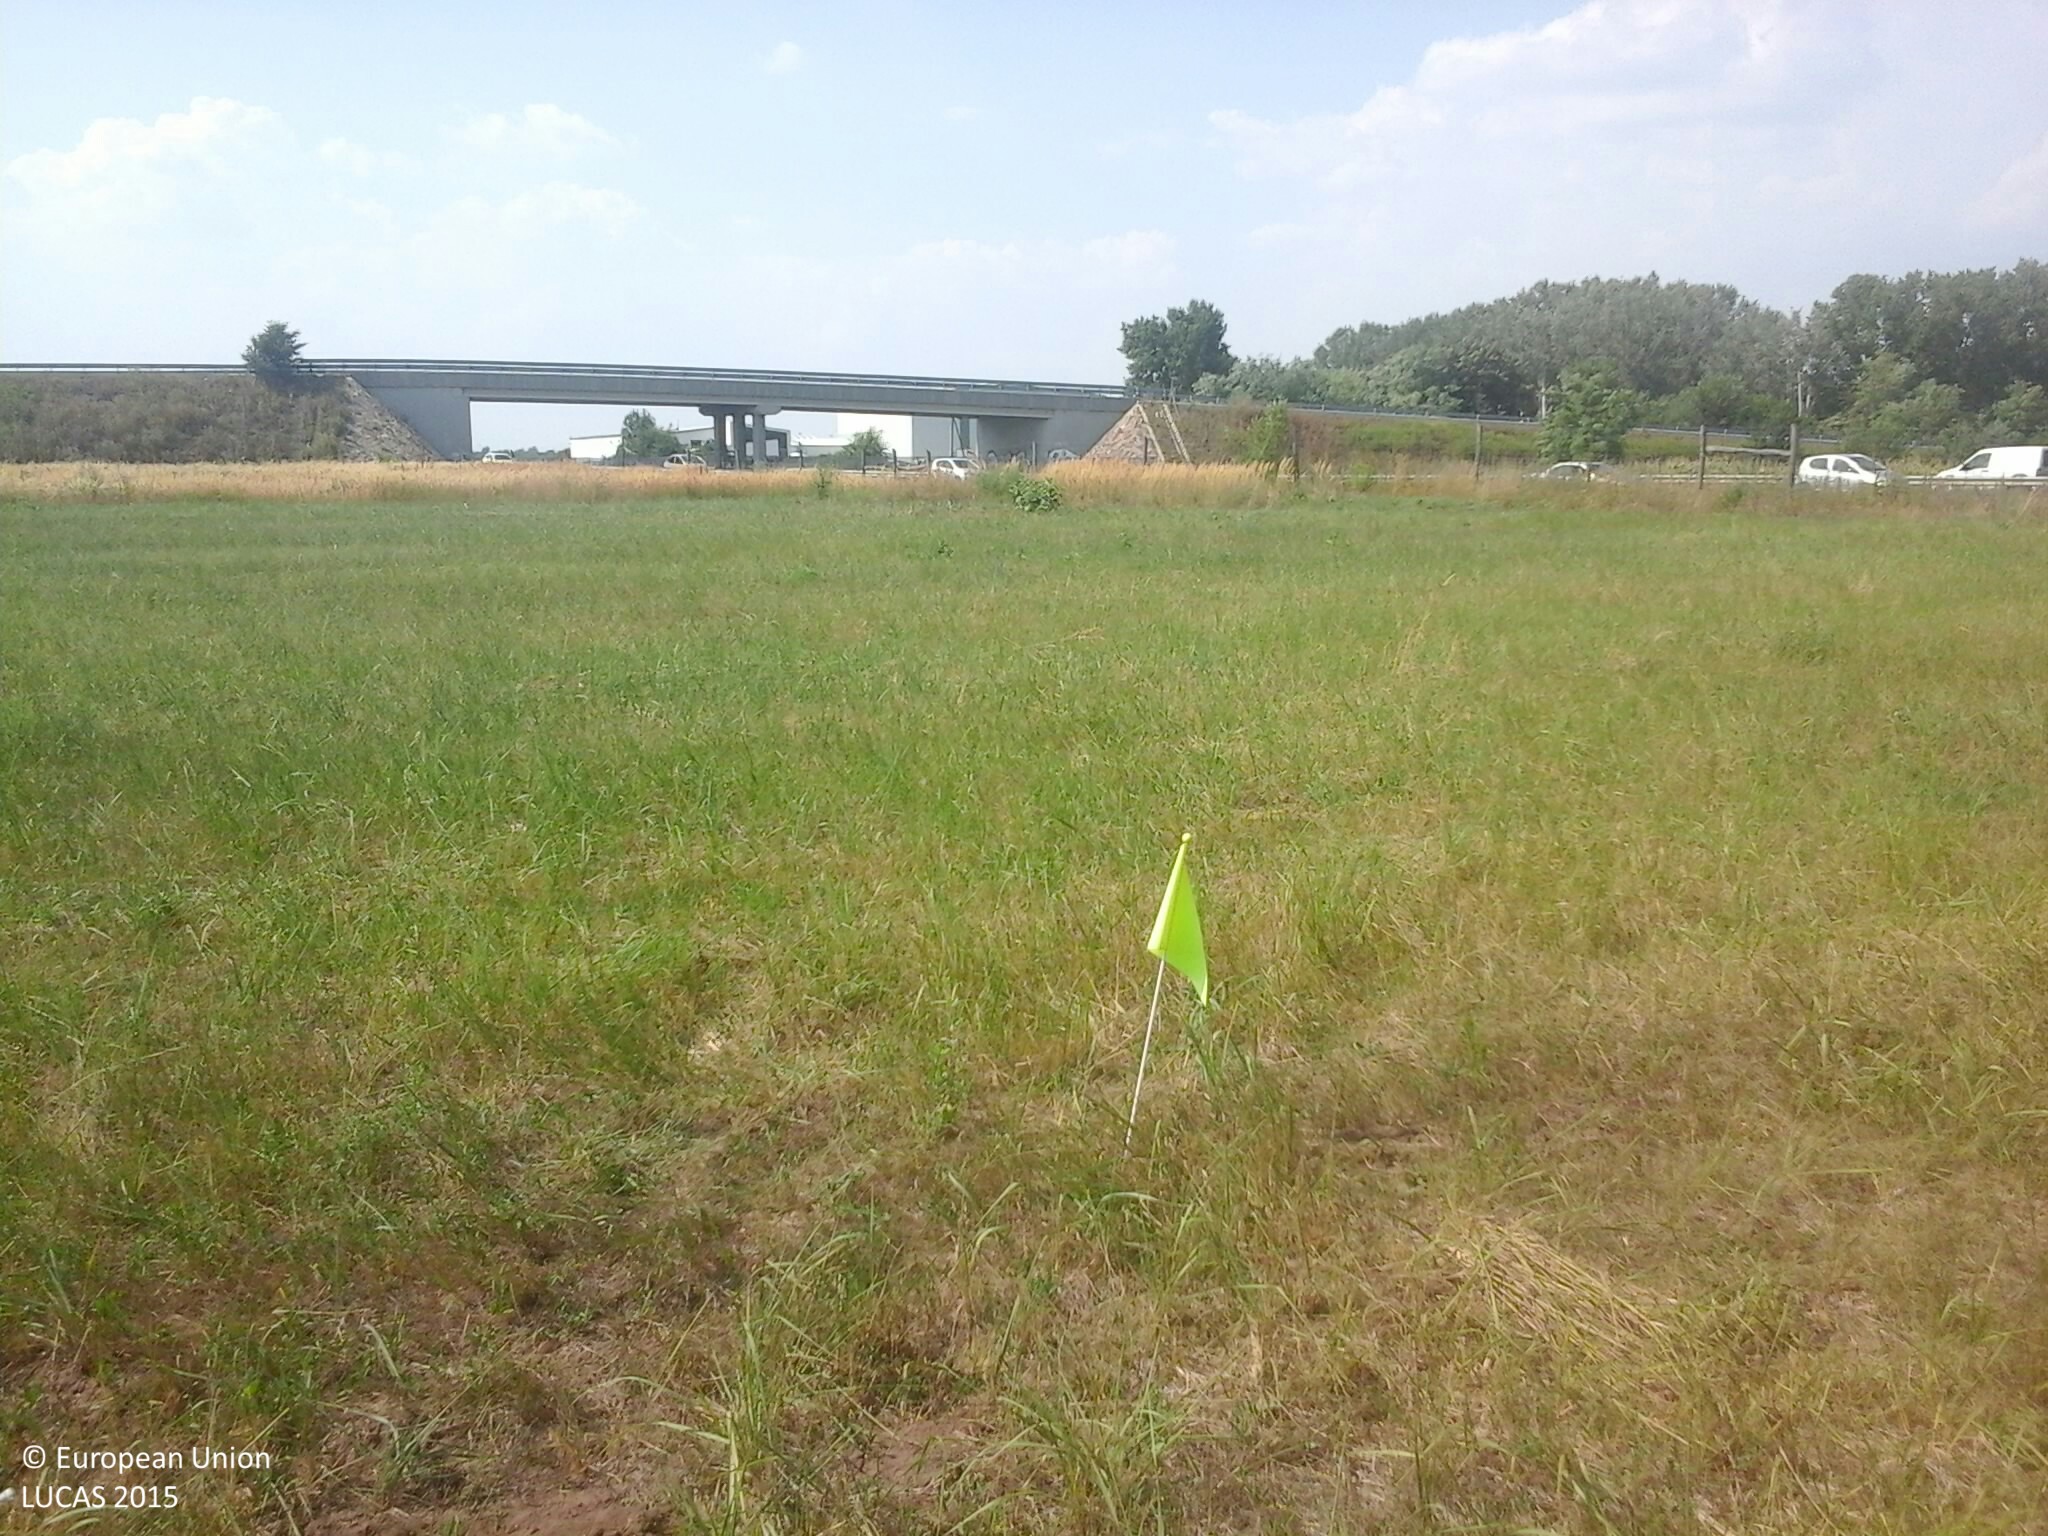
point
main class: Grassland
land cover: Grassland without tree/shrub cover
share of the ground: > 75 %
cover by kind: herbaceous plants 100 %
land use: Agriculture (excluding fallow land and kitchen gardens)
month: August
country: HU
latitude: 47.4144
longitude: 19.2837
